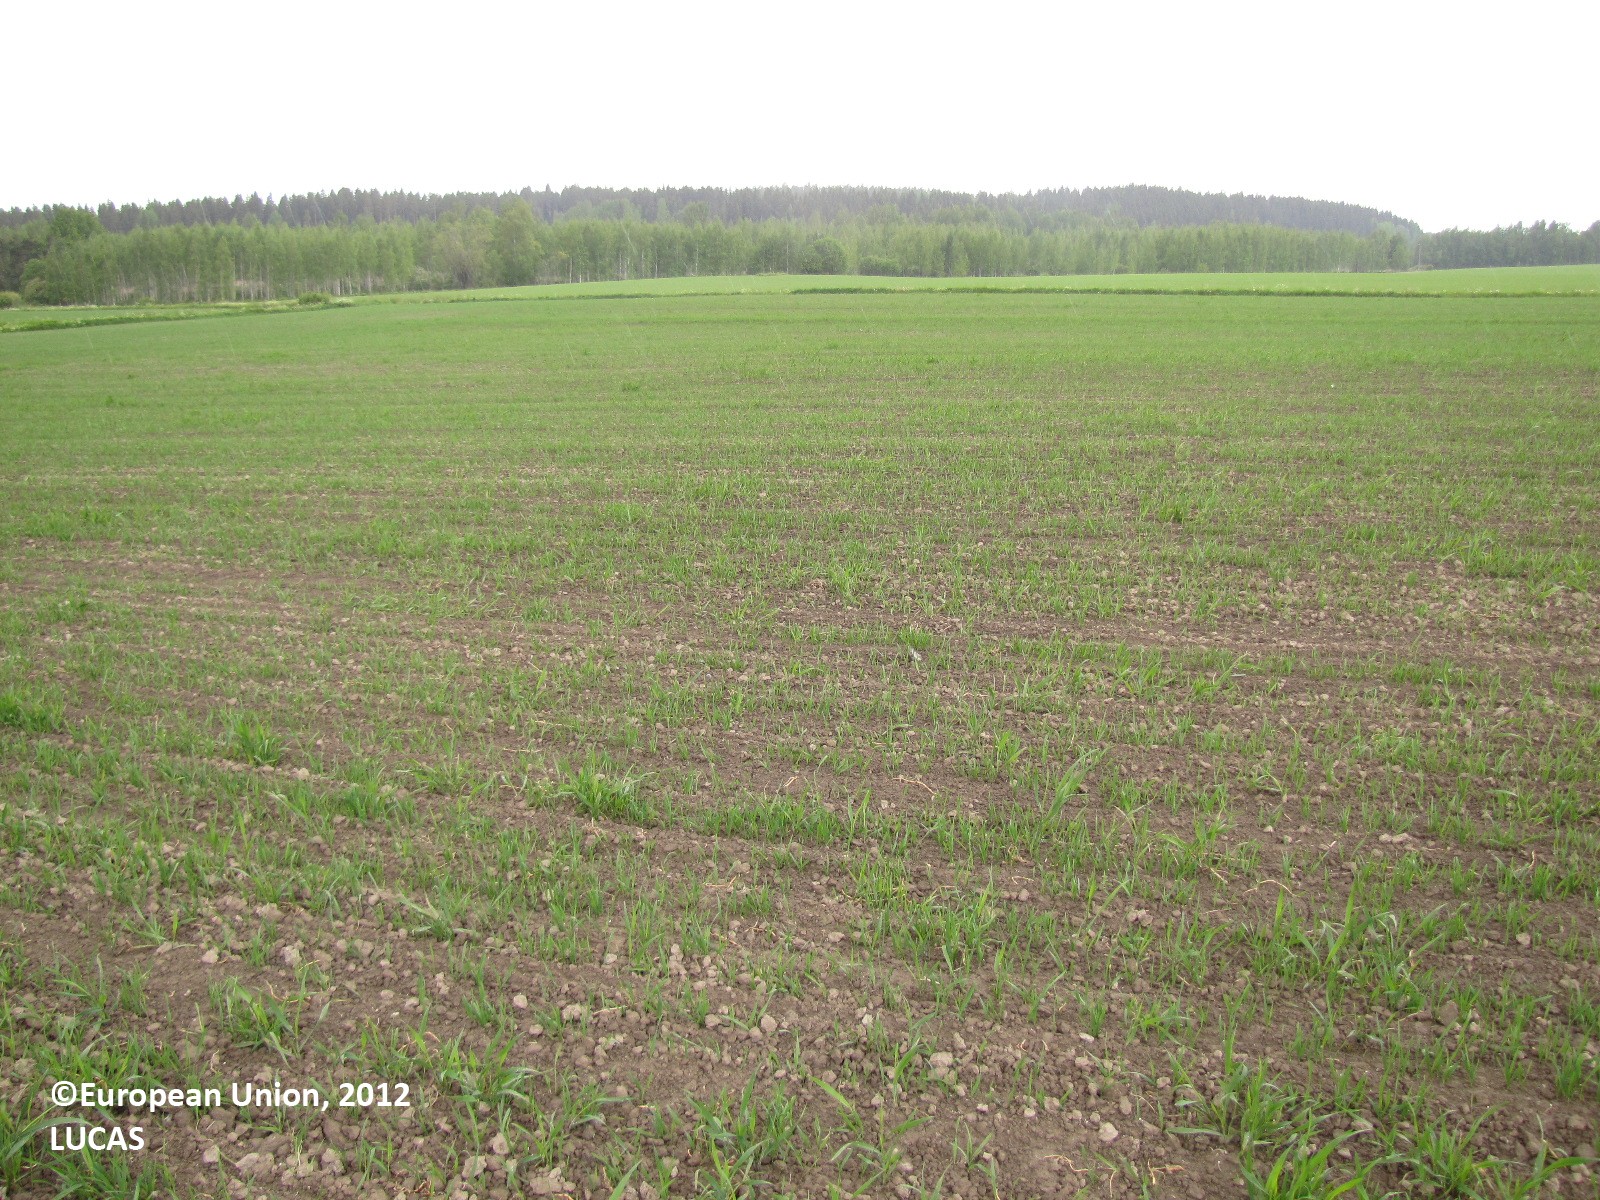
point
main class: Cropland
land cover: Common wheat
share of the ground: 25 - 50 %
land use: Agriculture (excluding fallow land and kitchen gardens)
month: June
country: FI
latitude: 61.2826
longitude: 23.5331
